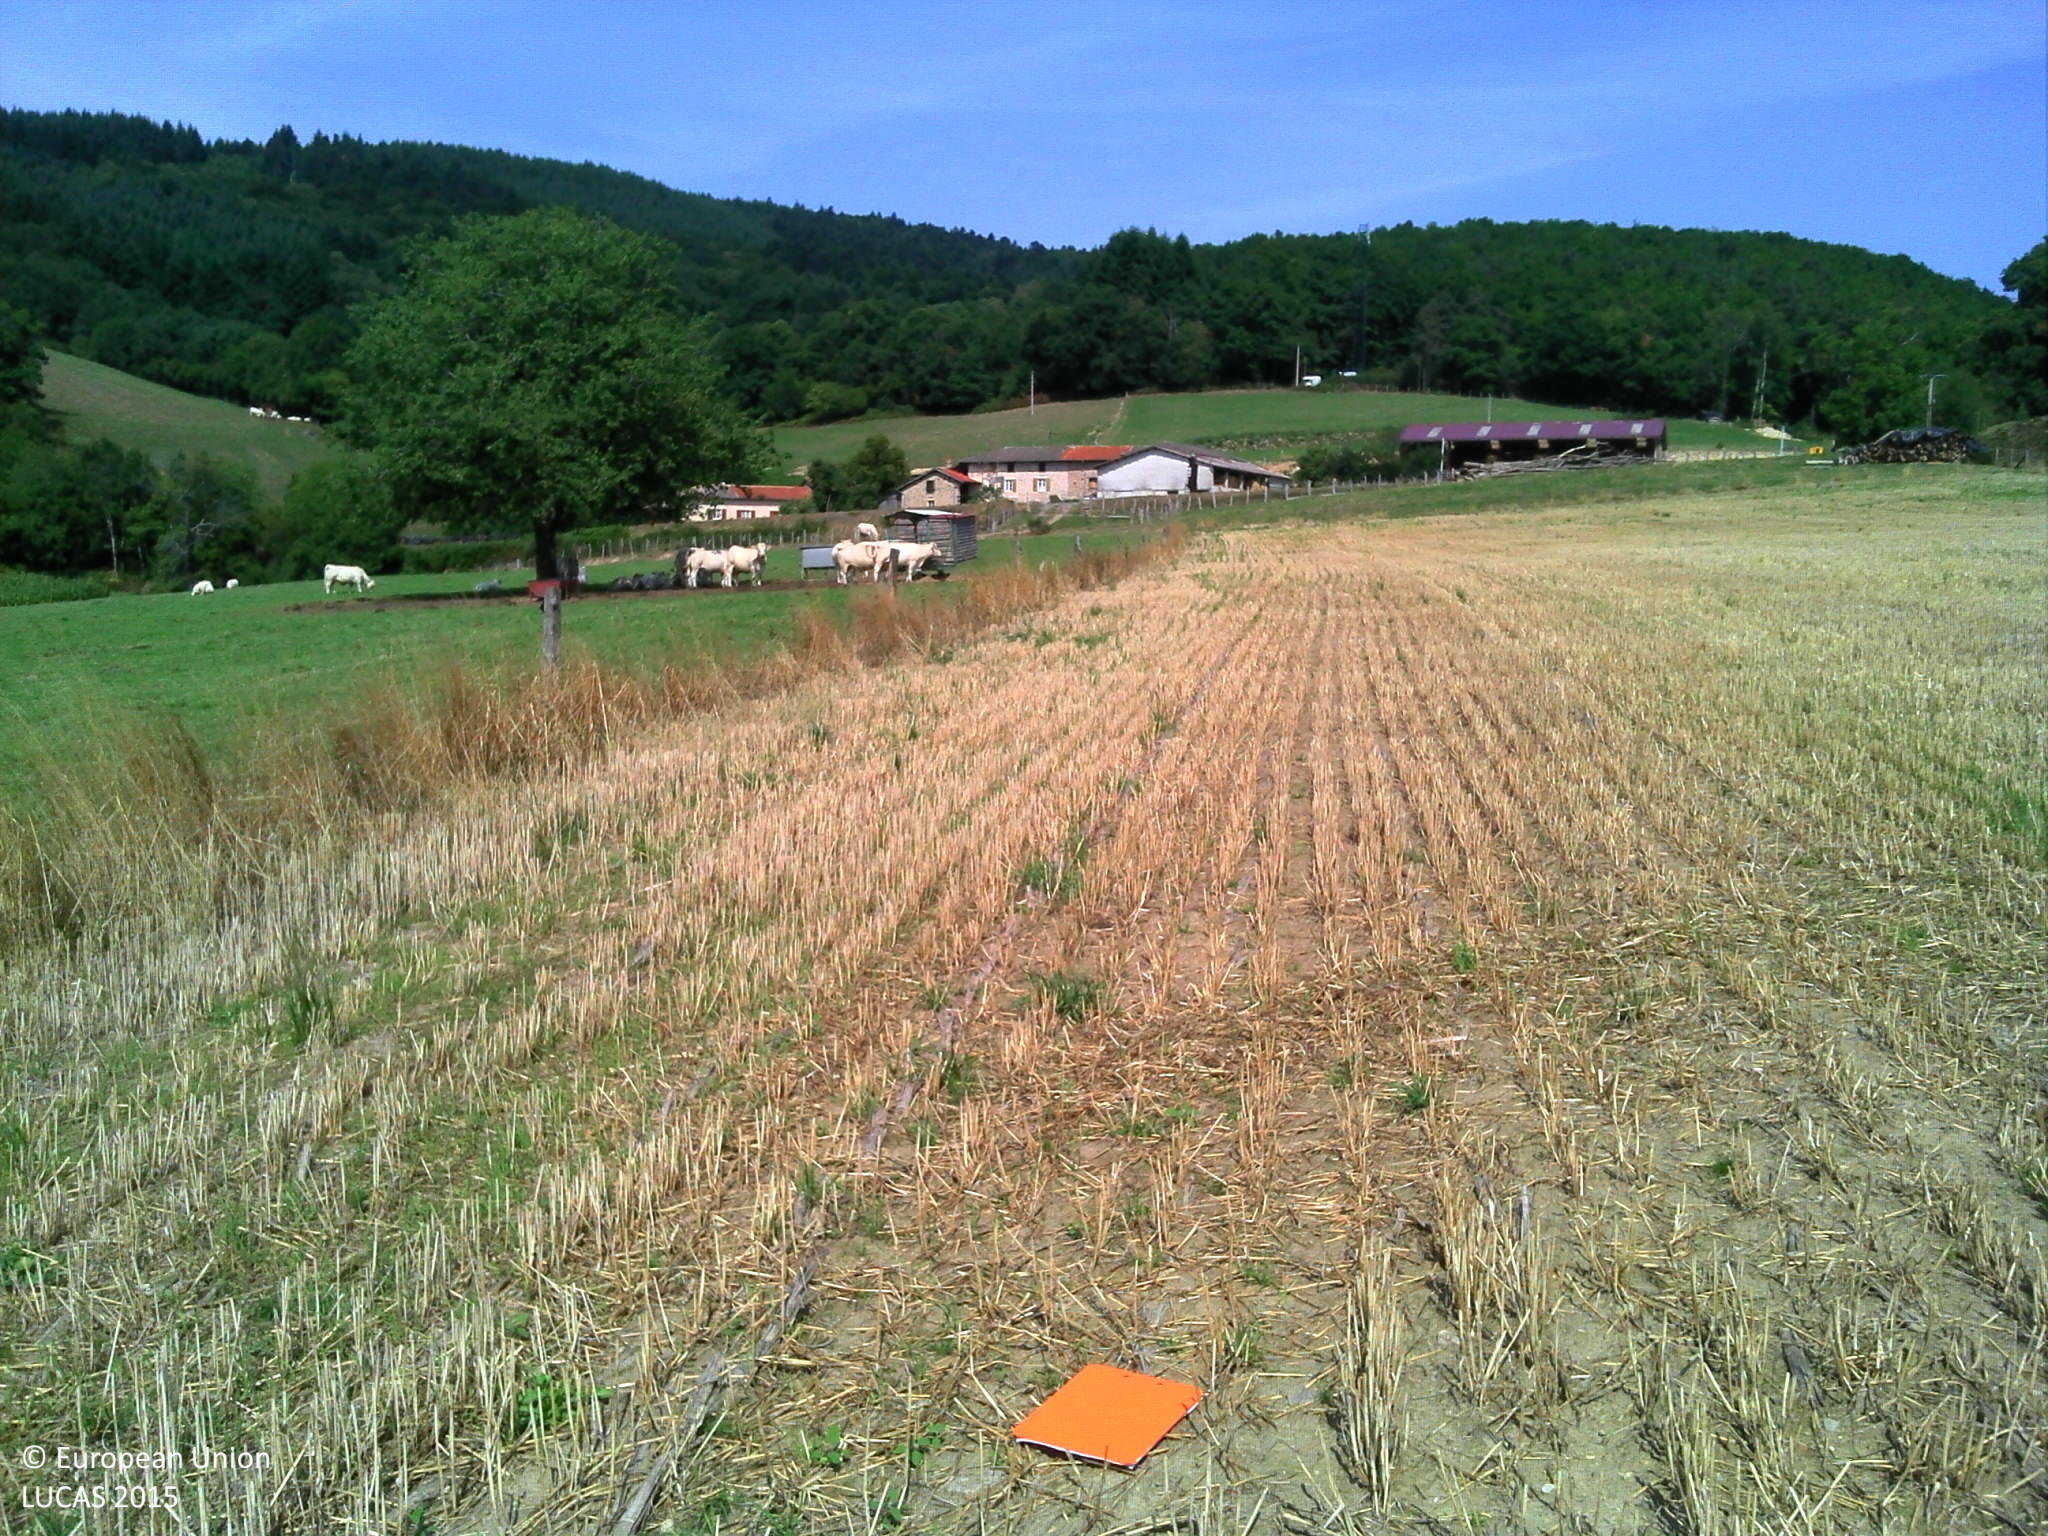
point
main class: Cropland
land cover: Common wheat
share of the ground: 50 - 75 %
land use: Agriculture (excluding fallow land and kitchen gardens)
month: August
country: FR
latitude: 46.1927
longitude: 4.5211
